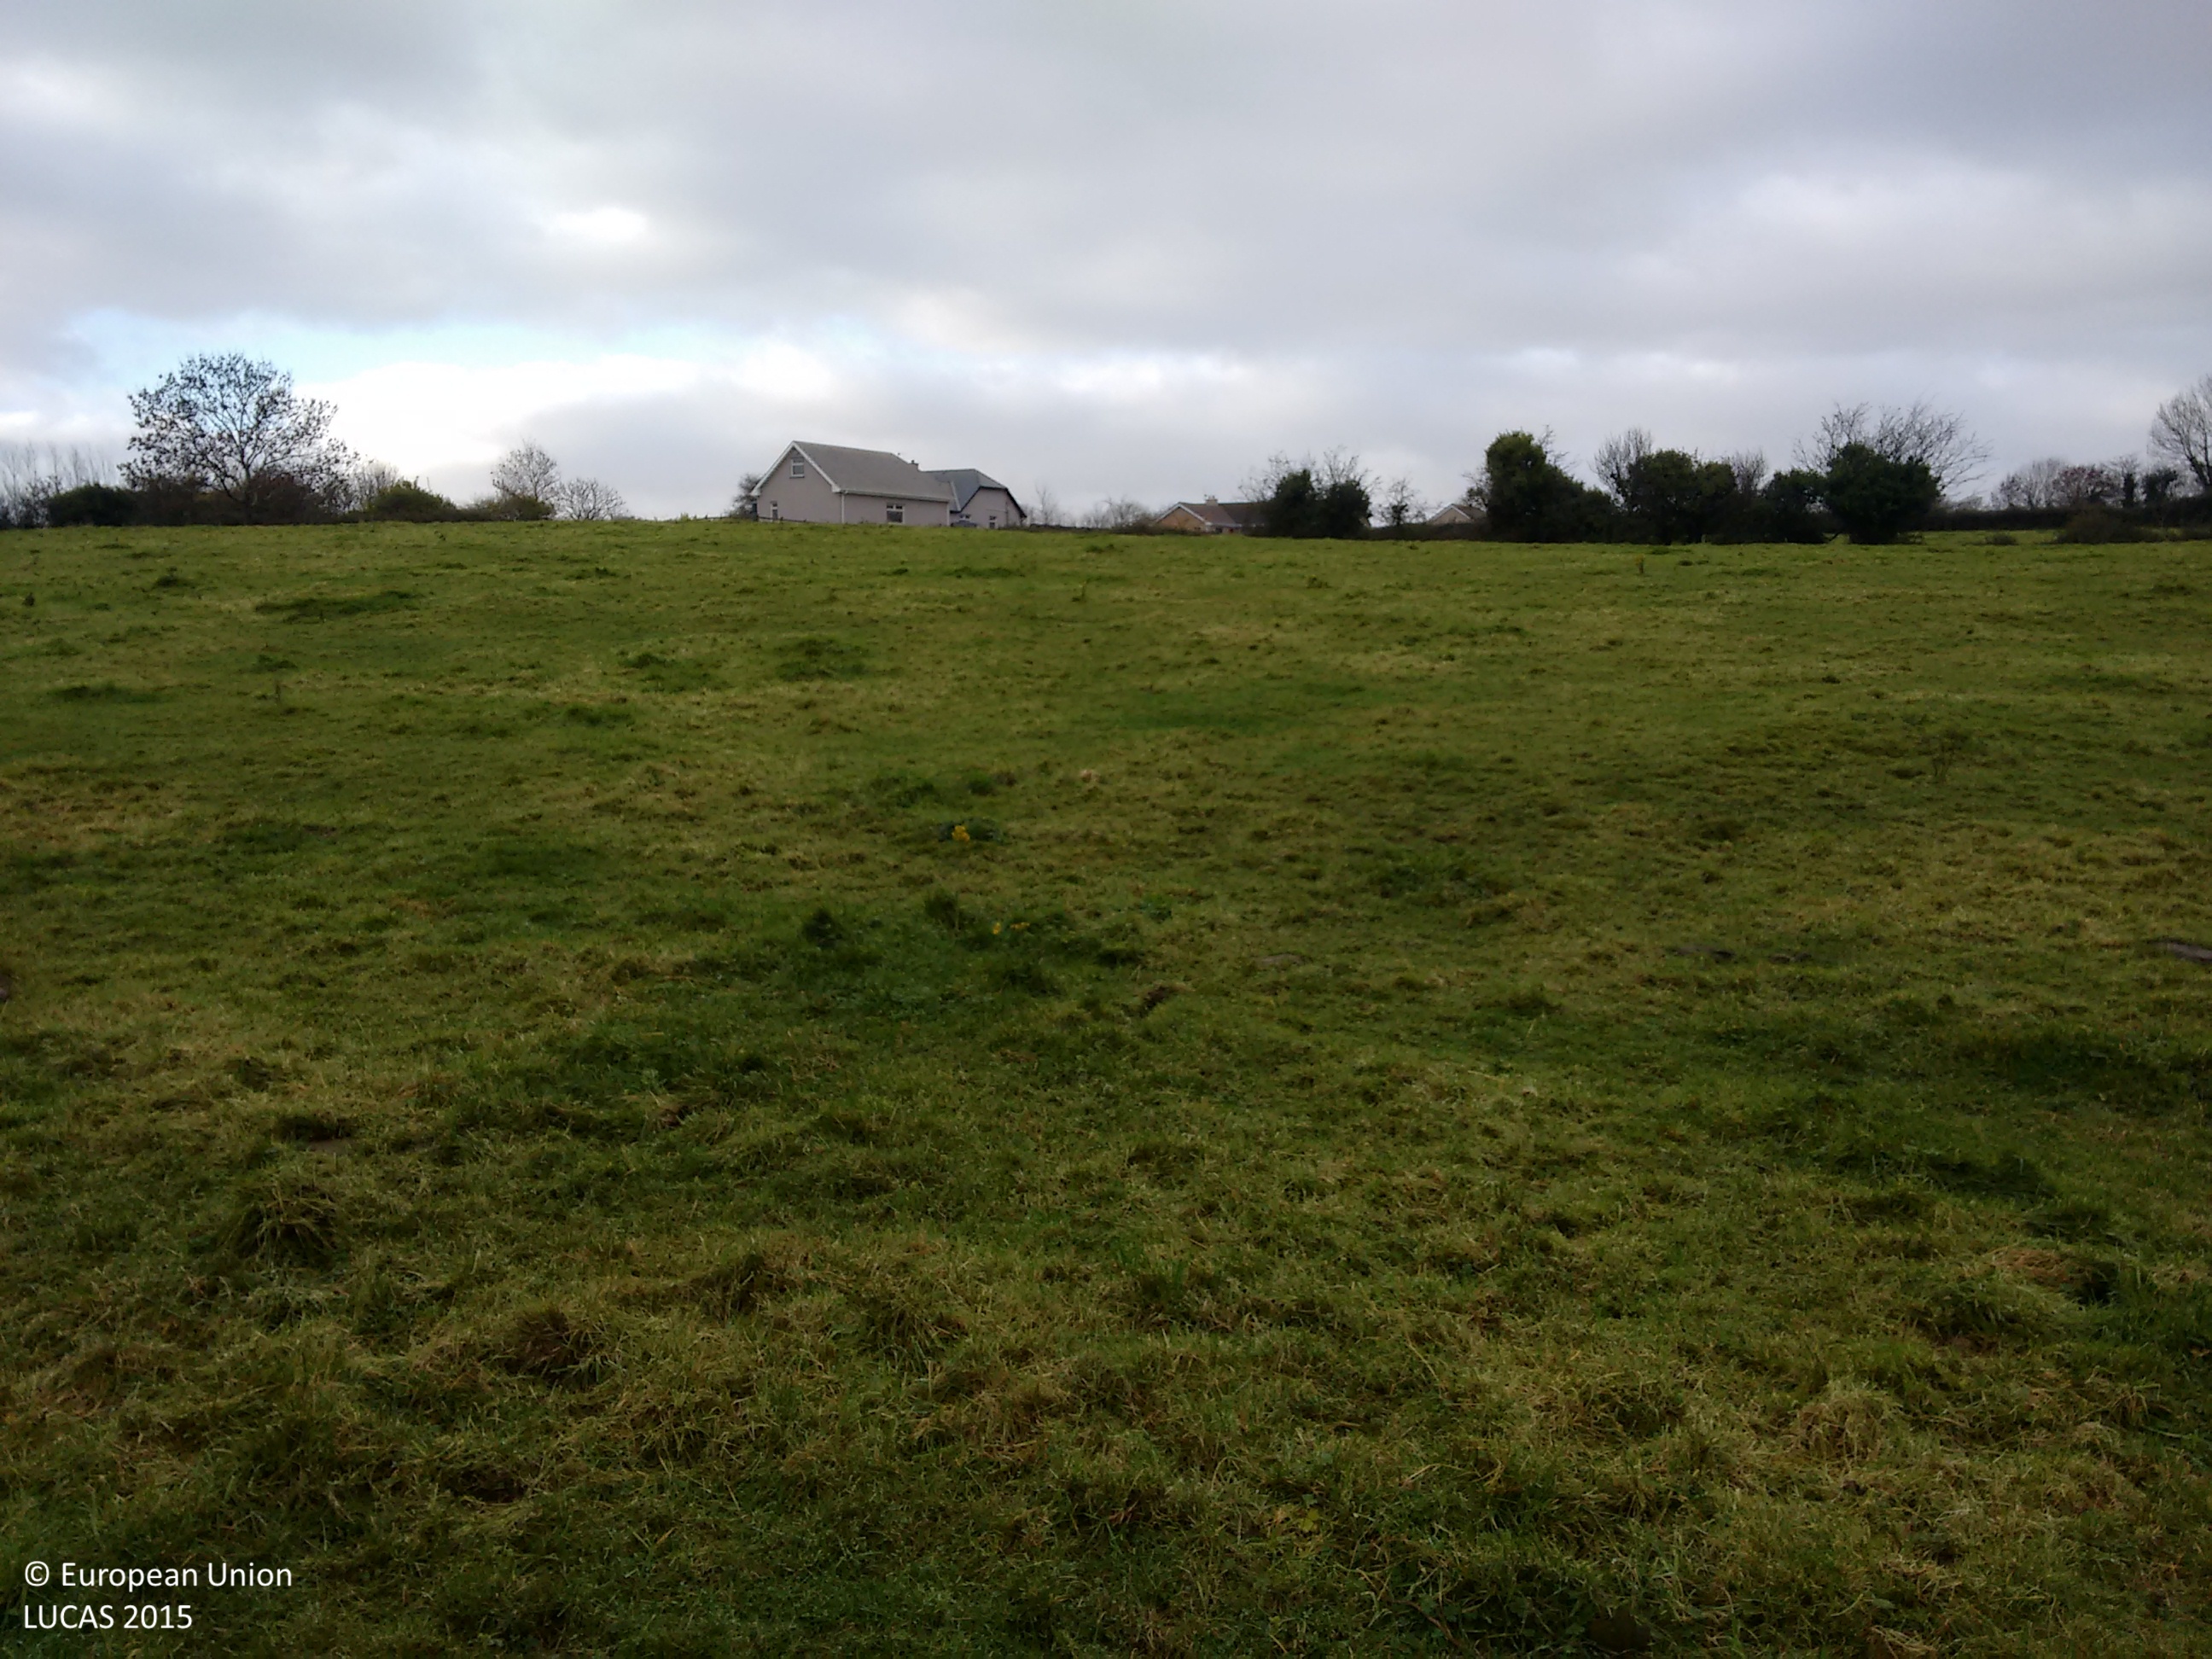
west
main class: Grassland
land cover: Grassland without tree/shrub cover
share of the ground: > 75 %
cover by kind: herbaceous plants 100 %
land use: Railway transport
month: November
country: IE
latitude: 54.2325
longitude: -8.4938
